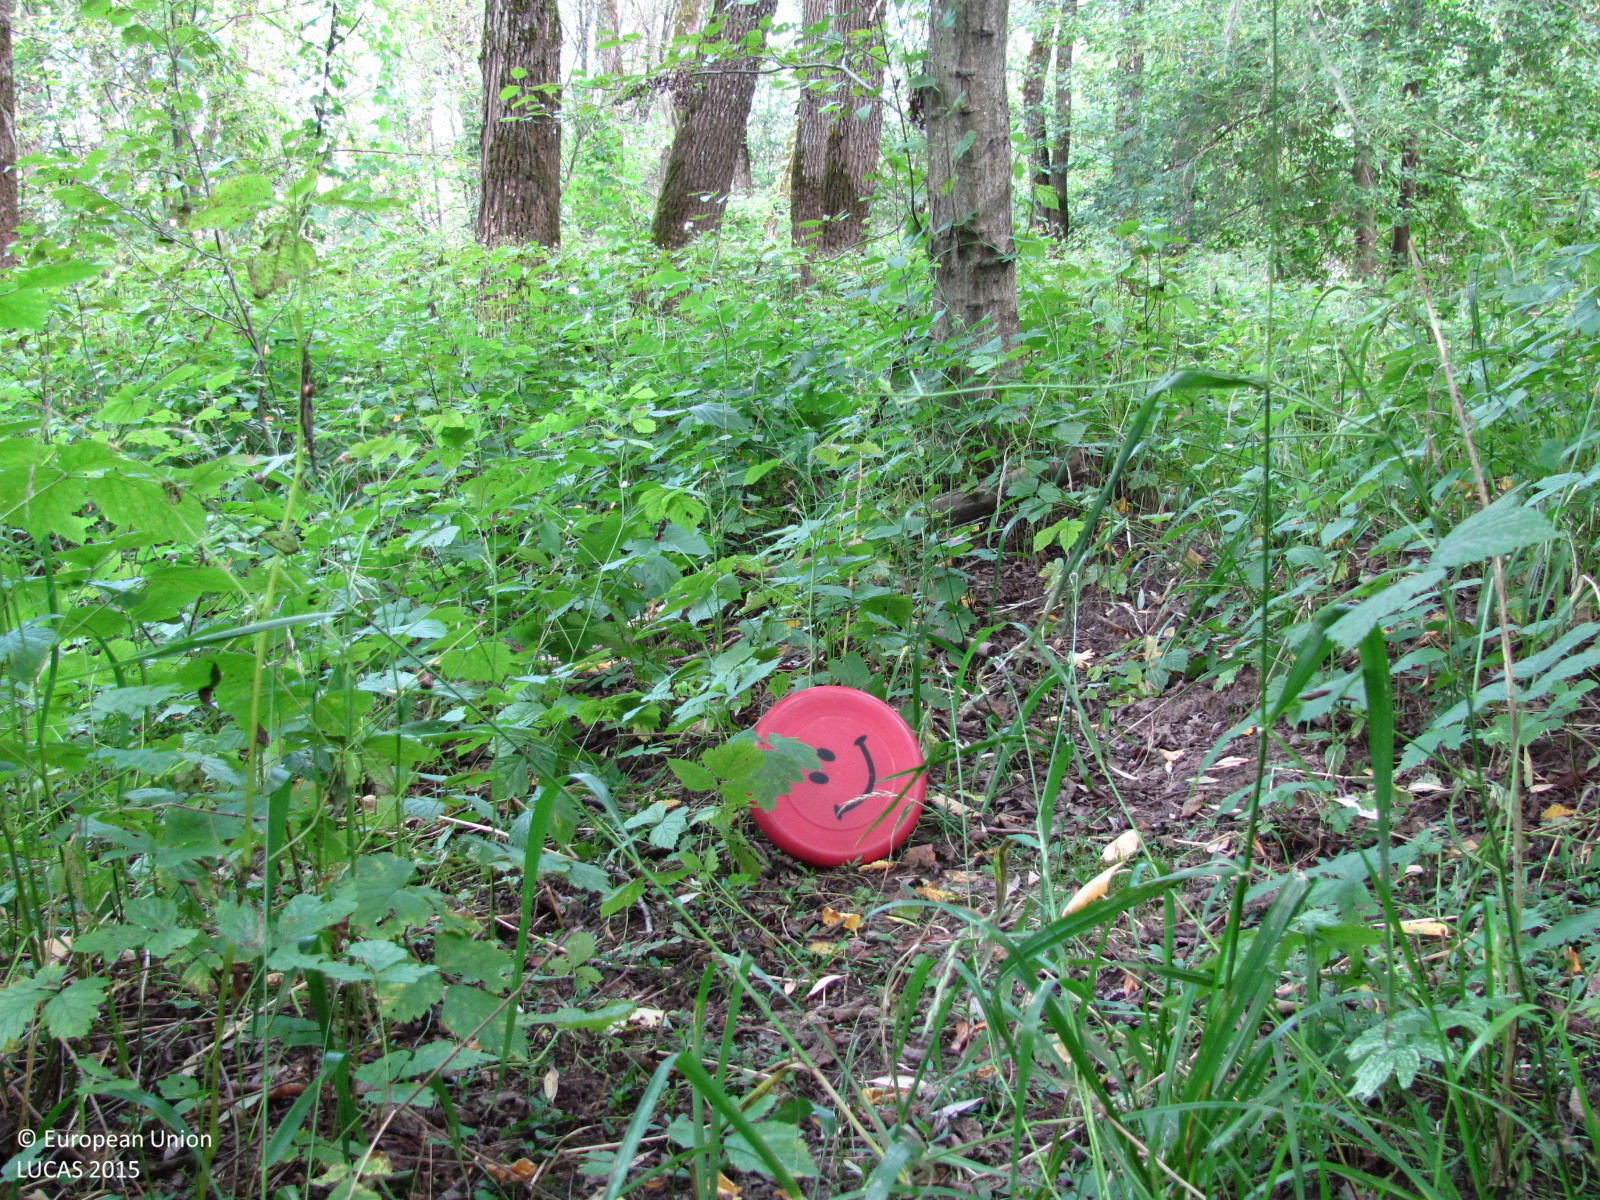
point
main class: Woodland
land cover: Broadleaved woodland
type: floodplain forest
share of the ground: > 75 %
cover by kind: broadleaved forest trees 80 %, herbaceous plants 15 %, unconsolidated bare surface 5 %
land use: Semi-natural and natural areas not in use
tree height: > 5 m
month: September
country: LV
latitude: 57.0975
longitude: 24.3341
